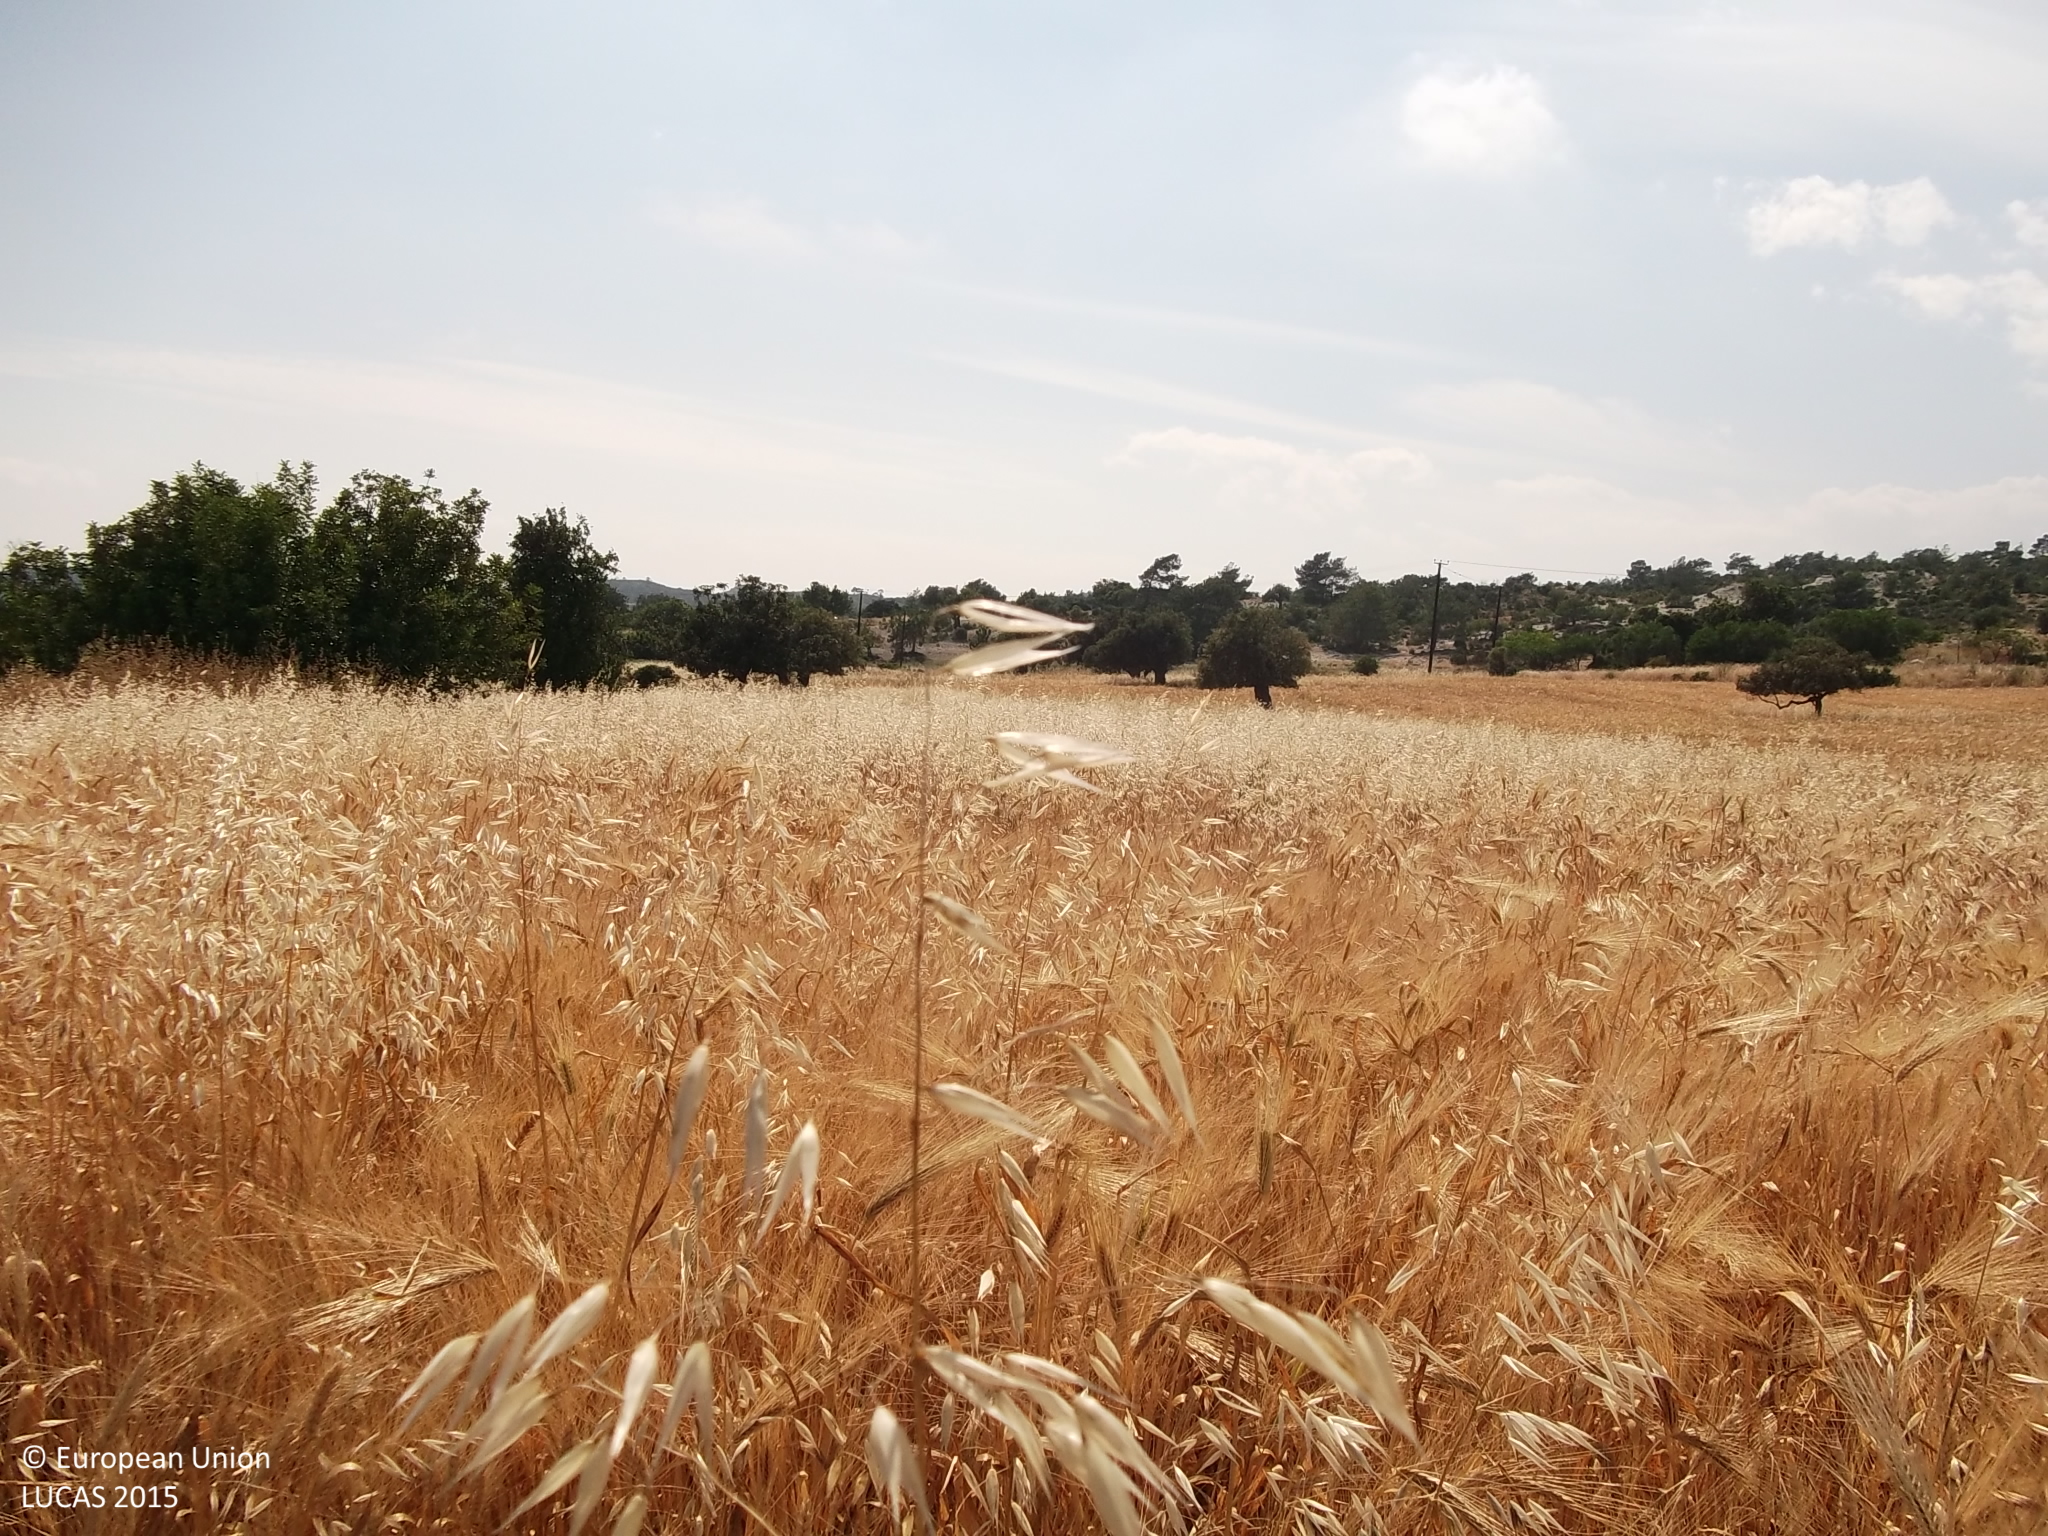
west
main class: Cropland
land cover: Mixed cereals for fodder
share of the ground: > 75 %
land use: Agriculture (excluding fallow land and kitchen gardens)
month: May
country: CY
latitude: 34.8052
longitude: 33.3207
